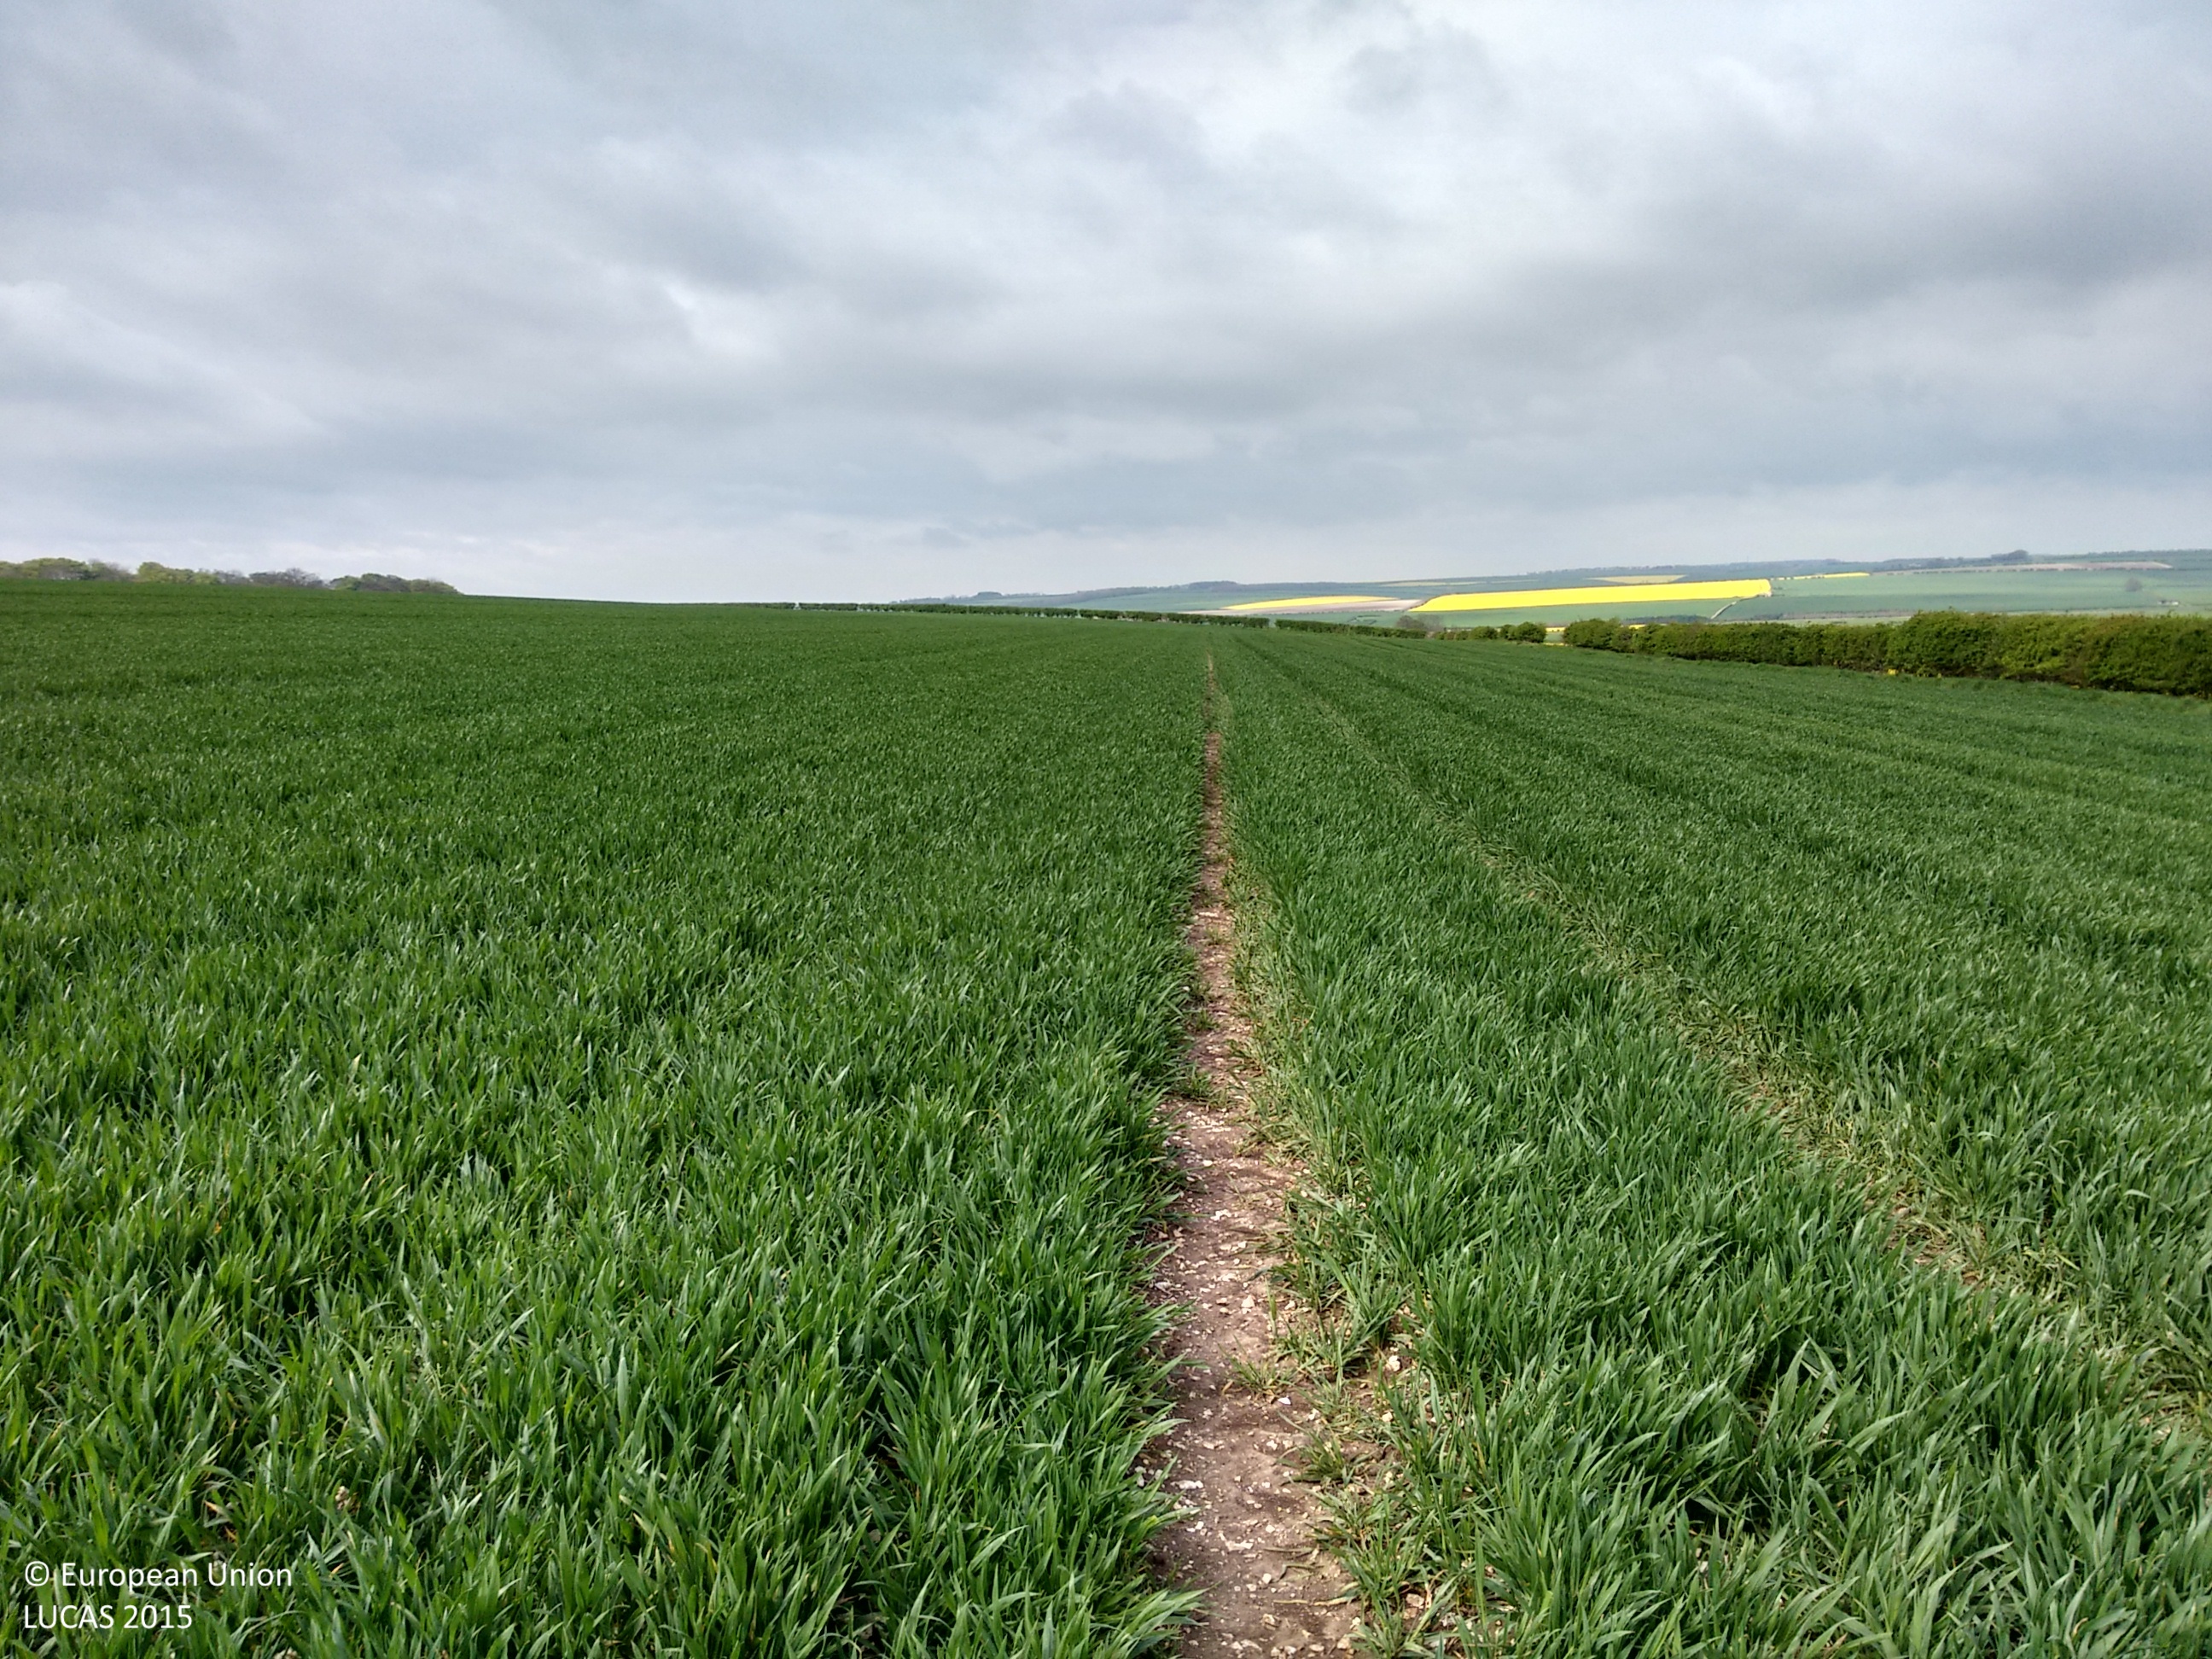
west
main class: Cropland
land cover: Common wheat
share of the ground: > 75 %
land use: Agriculture (excluding fallow land and kitchen gardens)
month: May
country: GB
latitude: 54.1219
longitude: -0.3006
